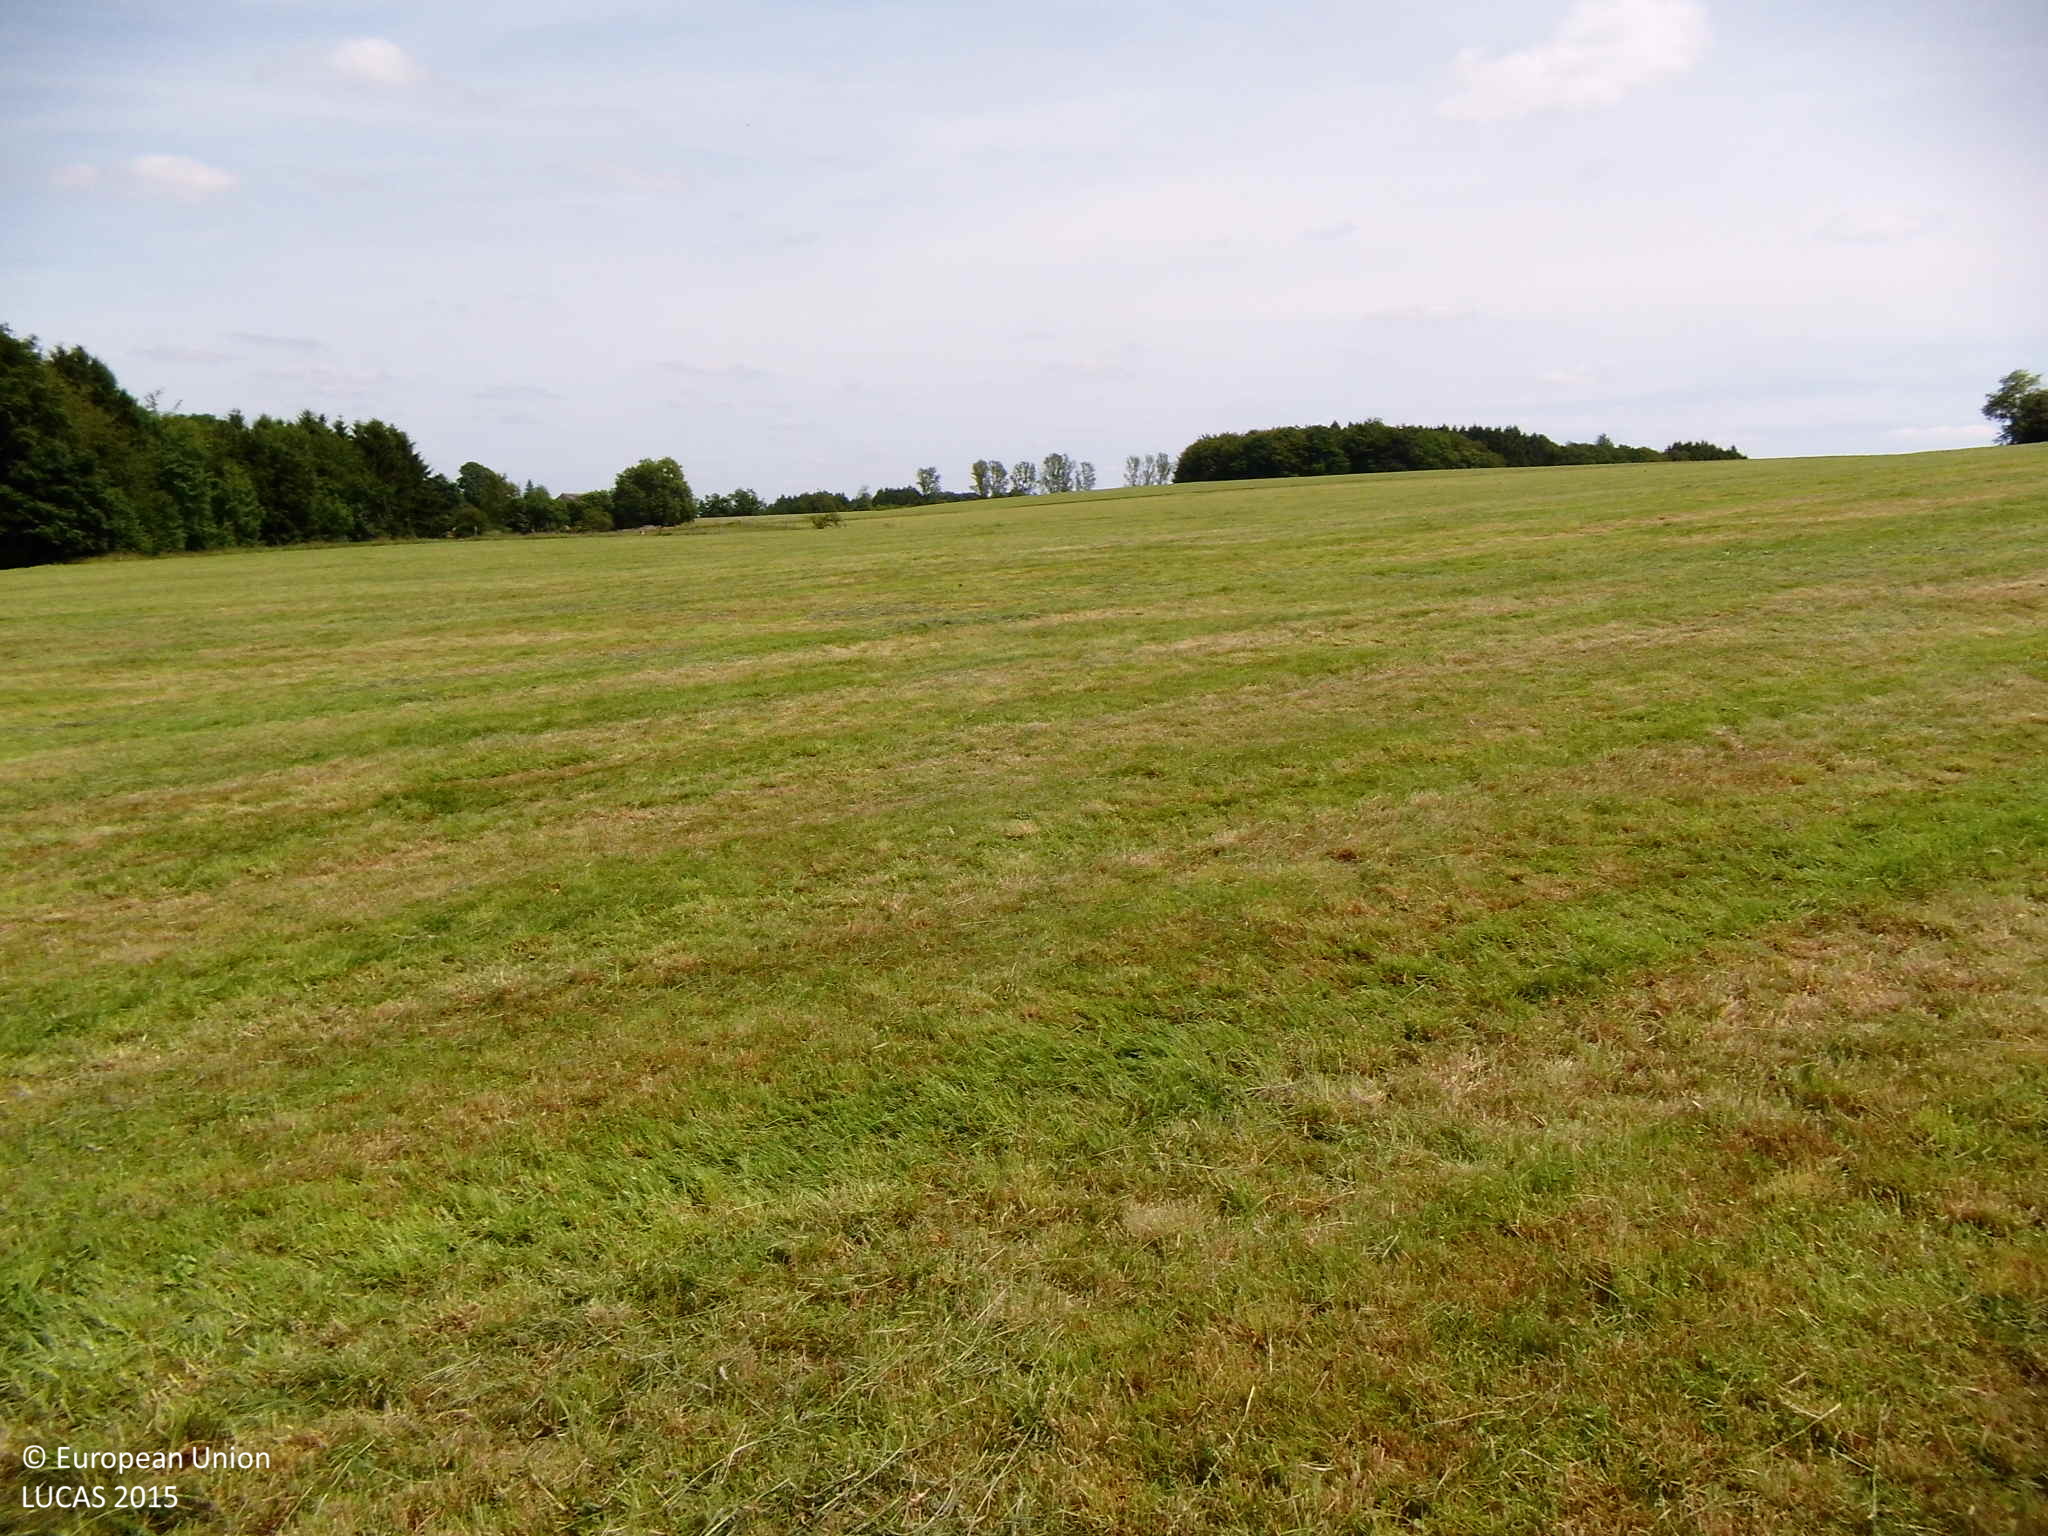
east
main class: Grassland
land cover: Grassland without tree/shrub cover
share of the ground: > 75 %
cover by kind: herbaceous plants 100 %
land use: Agriculture (excluding fallow land and kitchen gardens)
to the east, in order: Grassland without tree/shrub cover; Fences; Grassland without tree/shrub cover; Fences; Grassland without tree/shrub cover
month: June
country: DE
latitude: 51.1090
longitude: 7.4435
